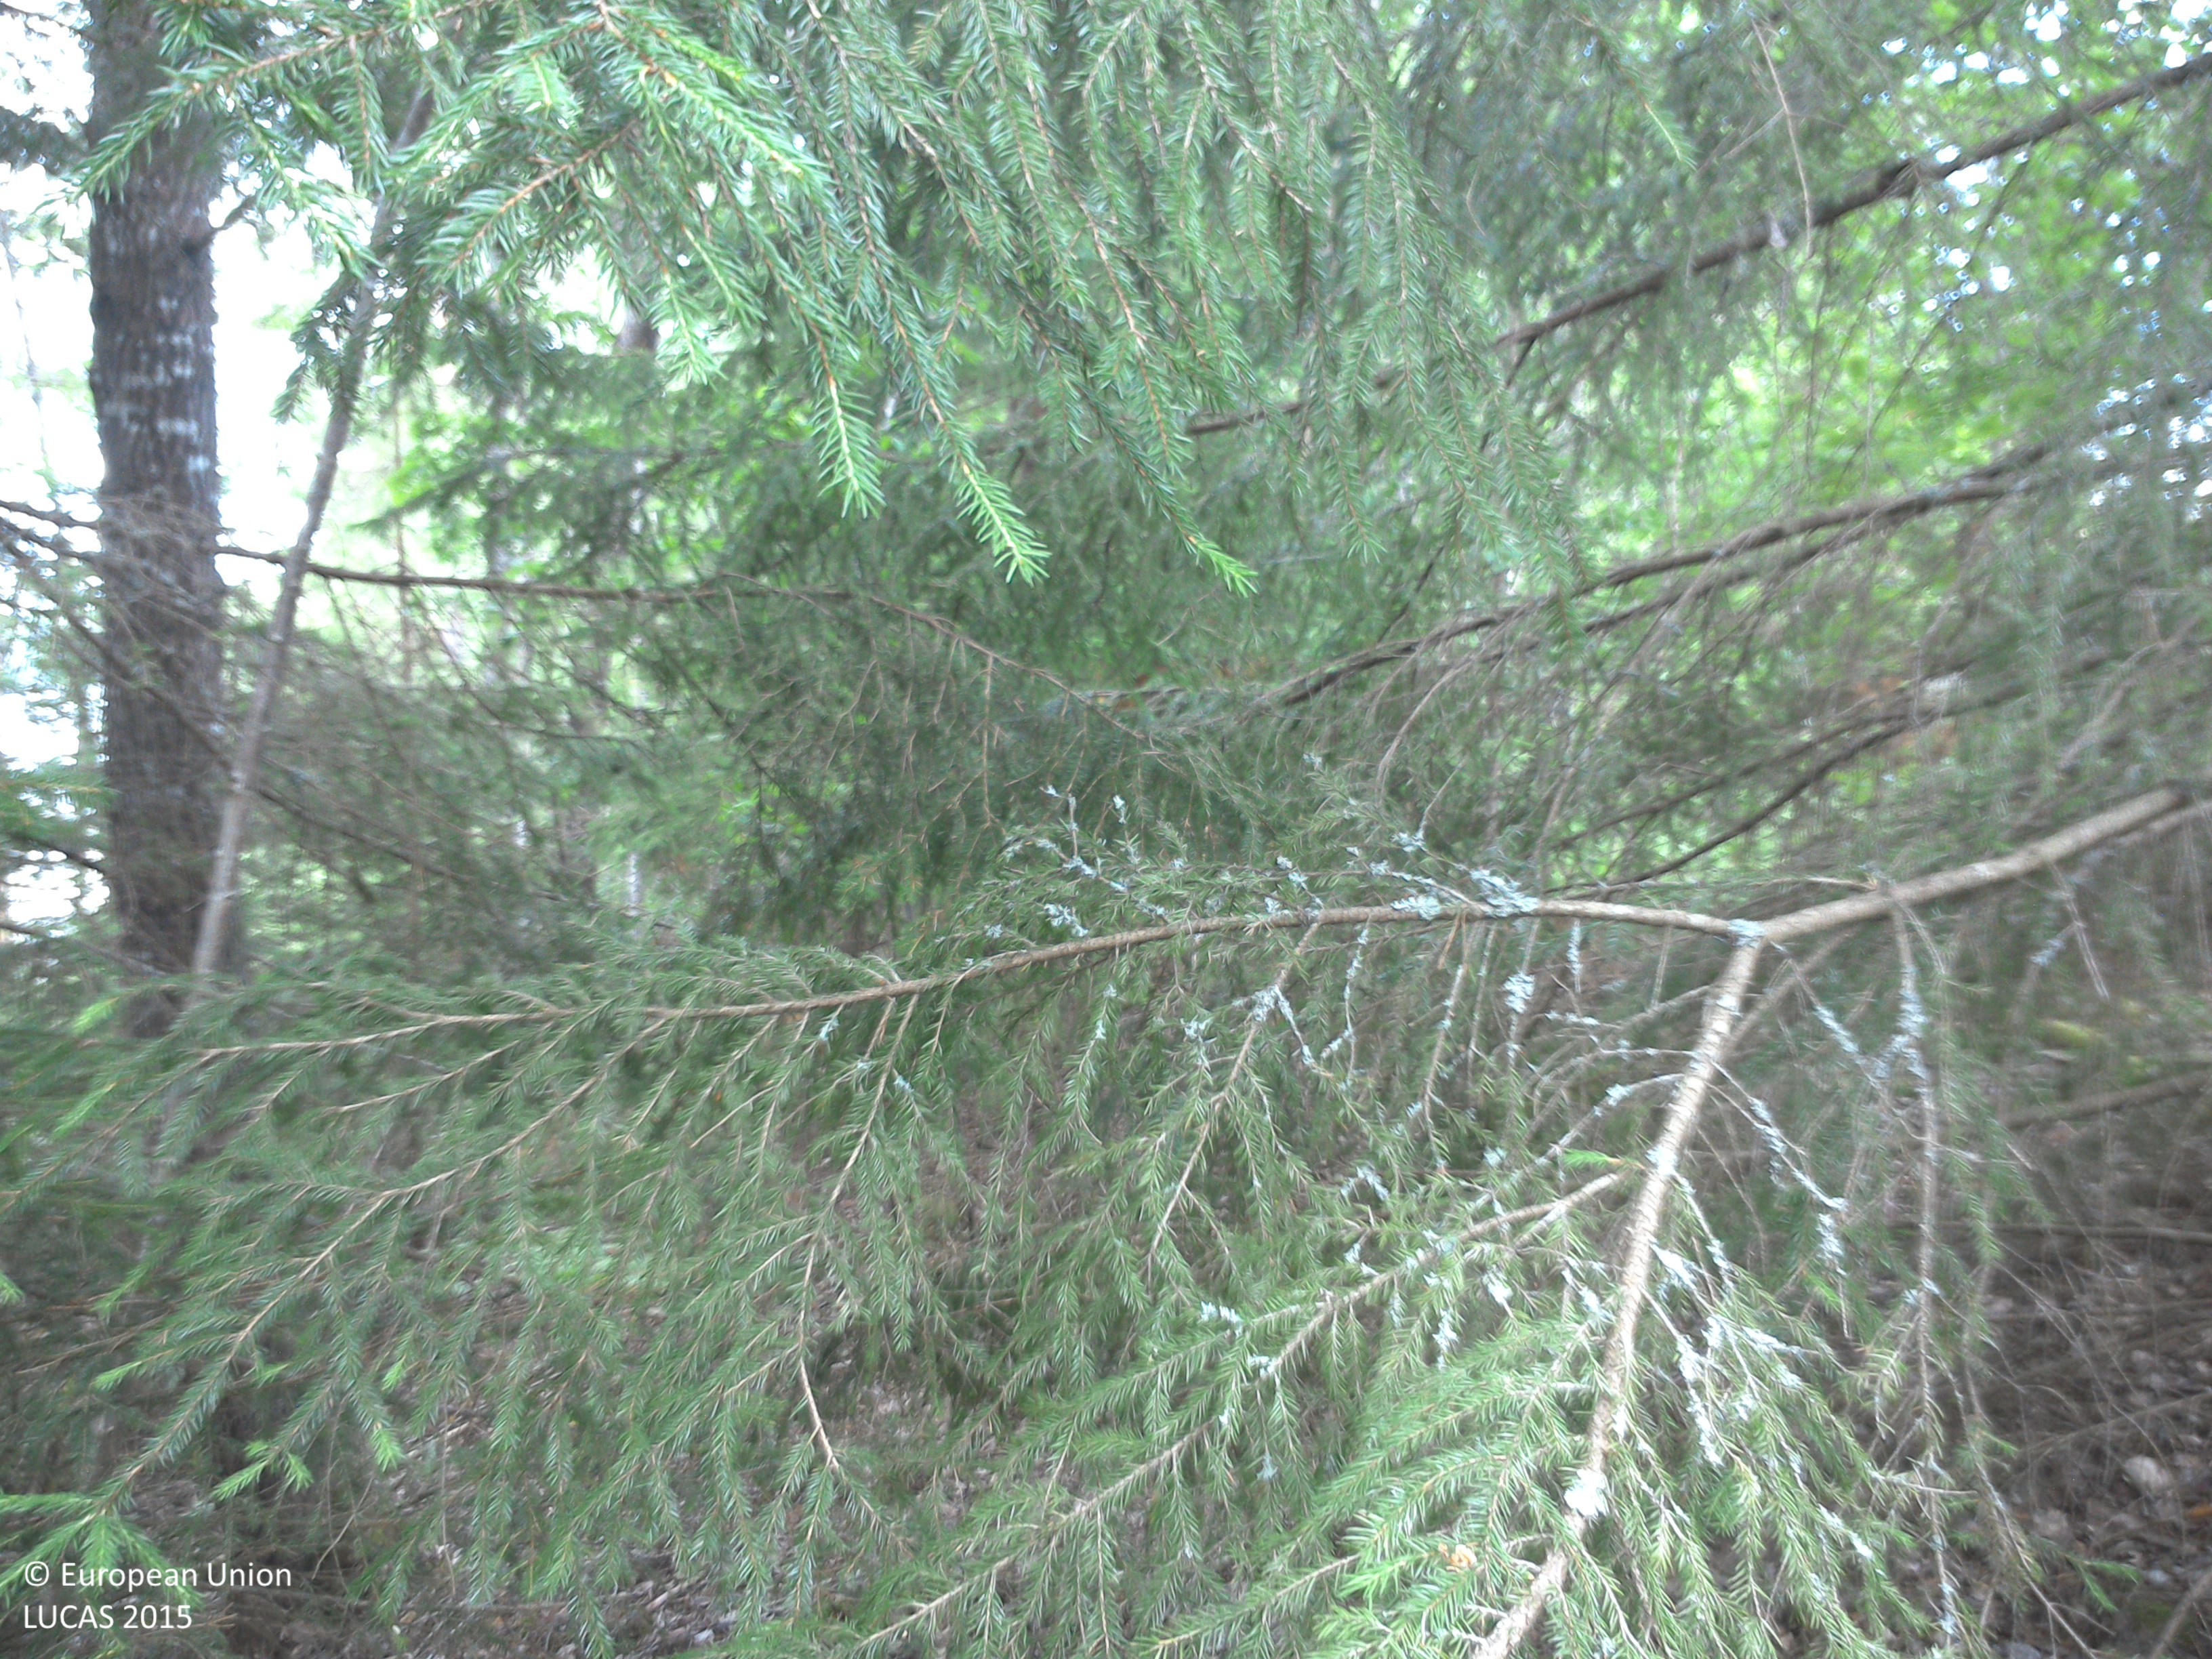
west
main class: Woodland
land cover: Spruce dominated mixed woodland
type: boreal forest
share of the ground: > 75 %
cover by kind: coniferous forest trees 50 %, broadleaved forest trees 25 %, herbaceous plants 15 %, lichens and mosses 10 %
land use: Forestry
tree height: > 5 m
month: July
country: SE
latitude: 57.9042
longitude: 16.0209
